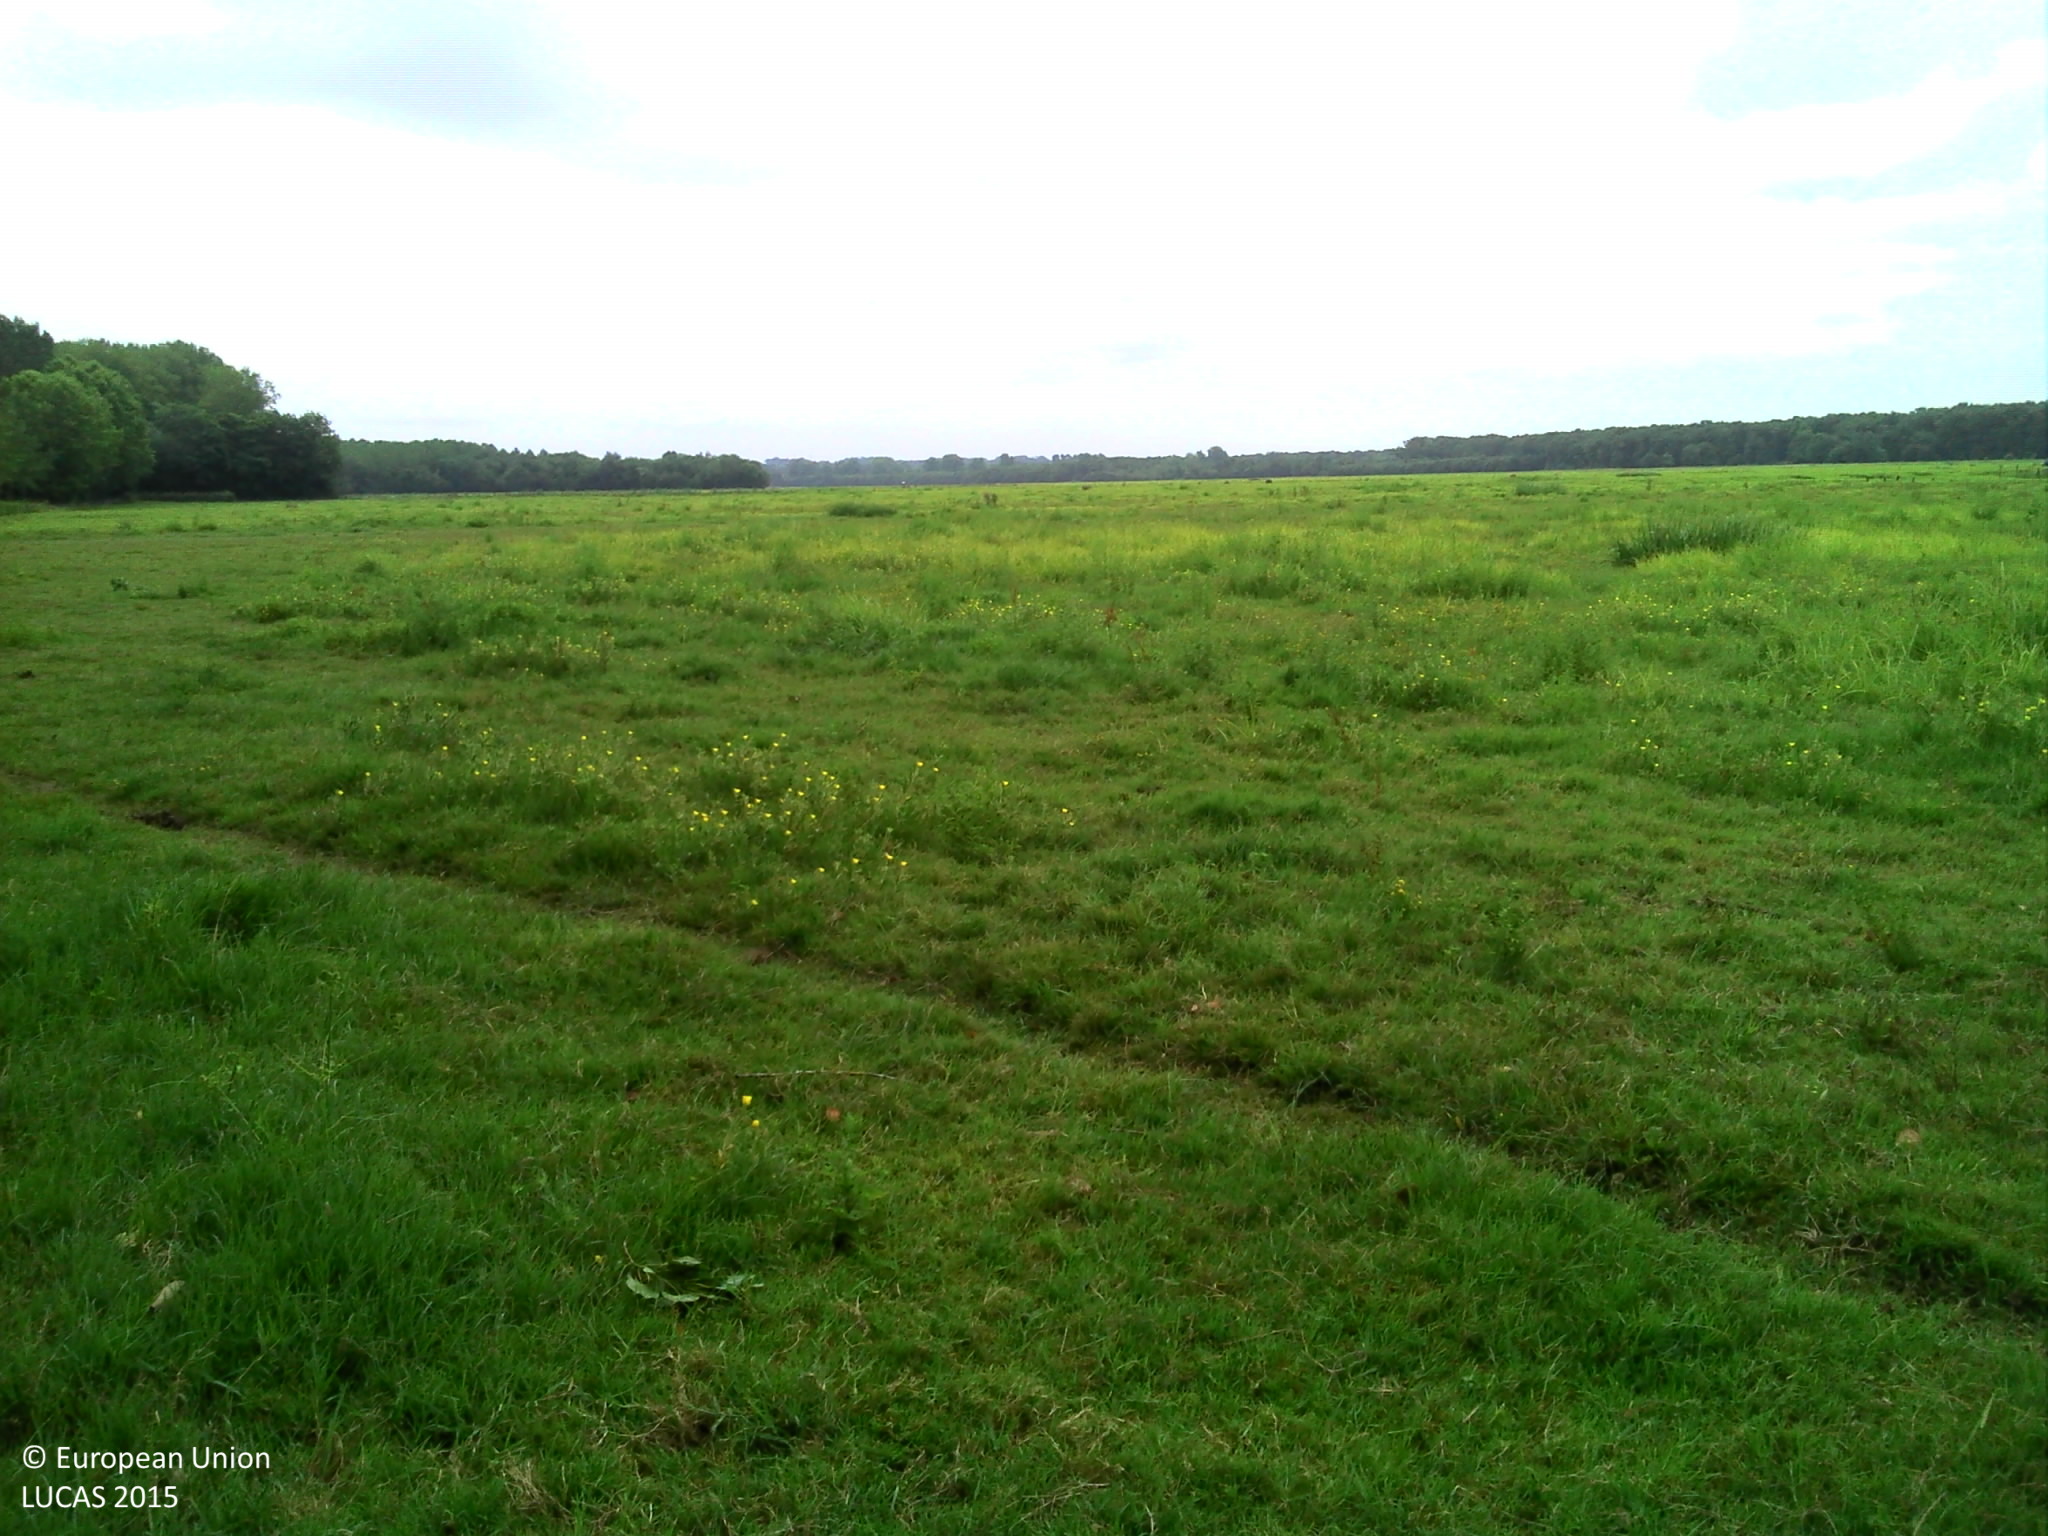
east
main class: Grassland
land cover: Grassland without tree/shrub cover
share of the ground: > 75 %
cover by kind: herbaceous plants 95 %, unconsolidated bare surface 5 %
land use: Agriculture (excluding fallow land and kitchen gardens)
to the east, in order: Grassland without tree/shrub cover; Rivers and streams; Spontaneously vegetated surfaces
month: July
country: FR
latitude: 43.6731
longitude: -1.1668
